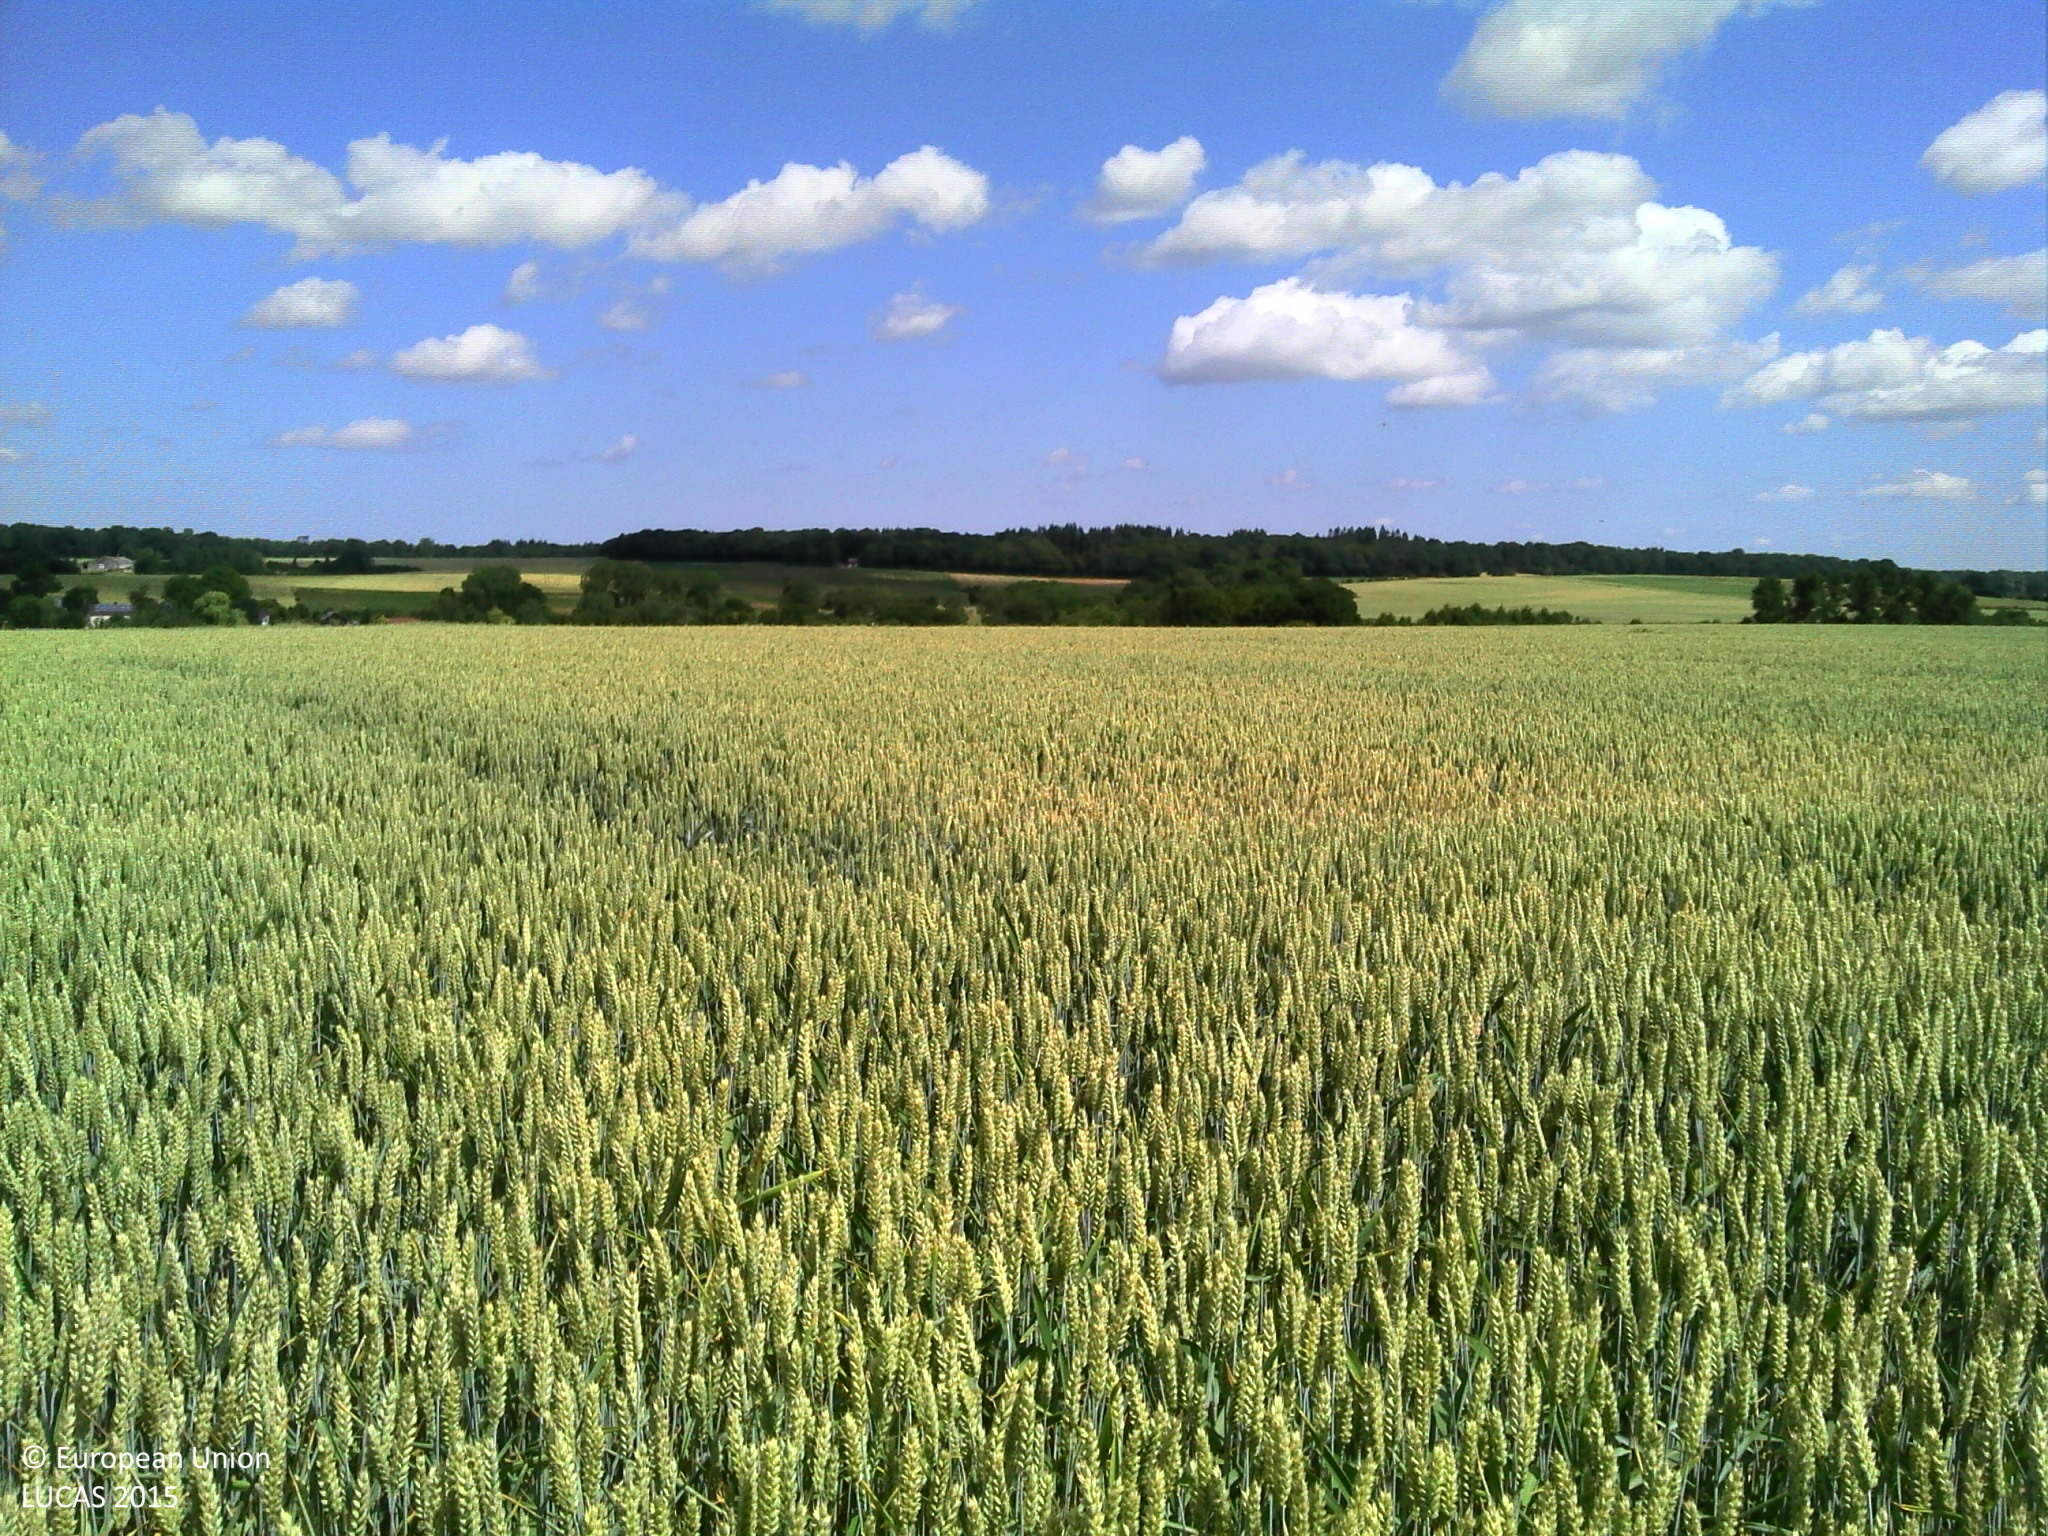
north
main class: Cropland
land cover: Common wheat
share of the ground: > 75 %
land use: Agriculture (excluding fallow land and kitchen gardens)
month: July
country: BE
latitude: 50.2338
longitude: 4.5425
